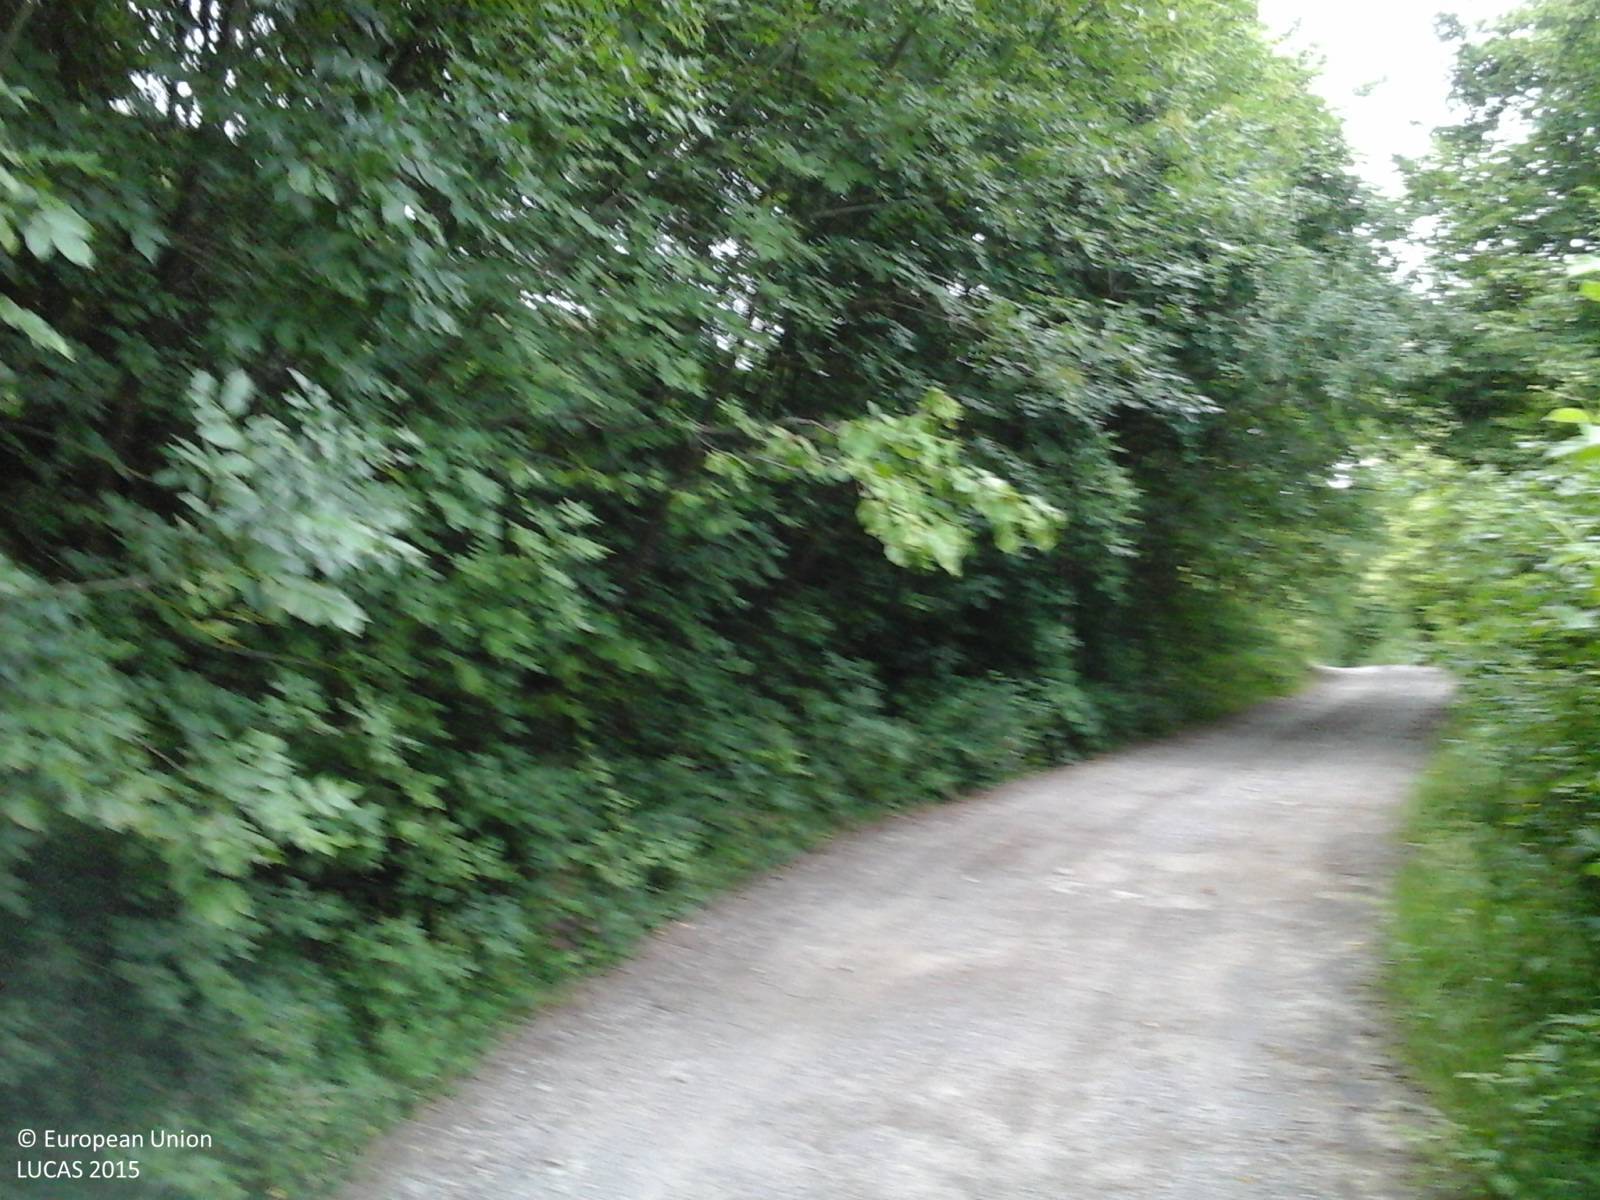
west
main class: Woodland
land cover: Broadleaved woodland
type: thermophilous deciduous forest
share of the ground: > 75 %
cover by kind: broadleaved forest trees 100 %
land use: Semi-natural and natural areas not in use
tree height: > 5 m
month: June
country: IT
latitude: 44.2422
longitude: 10.1874
